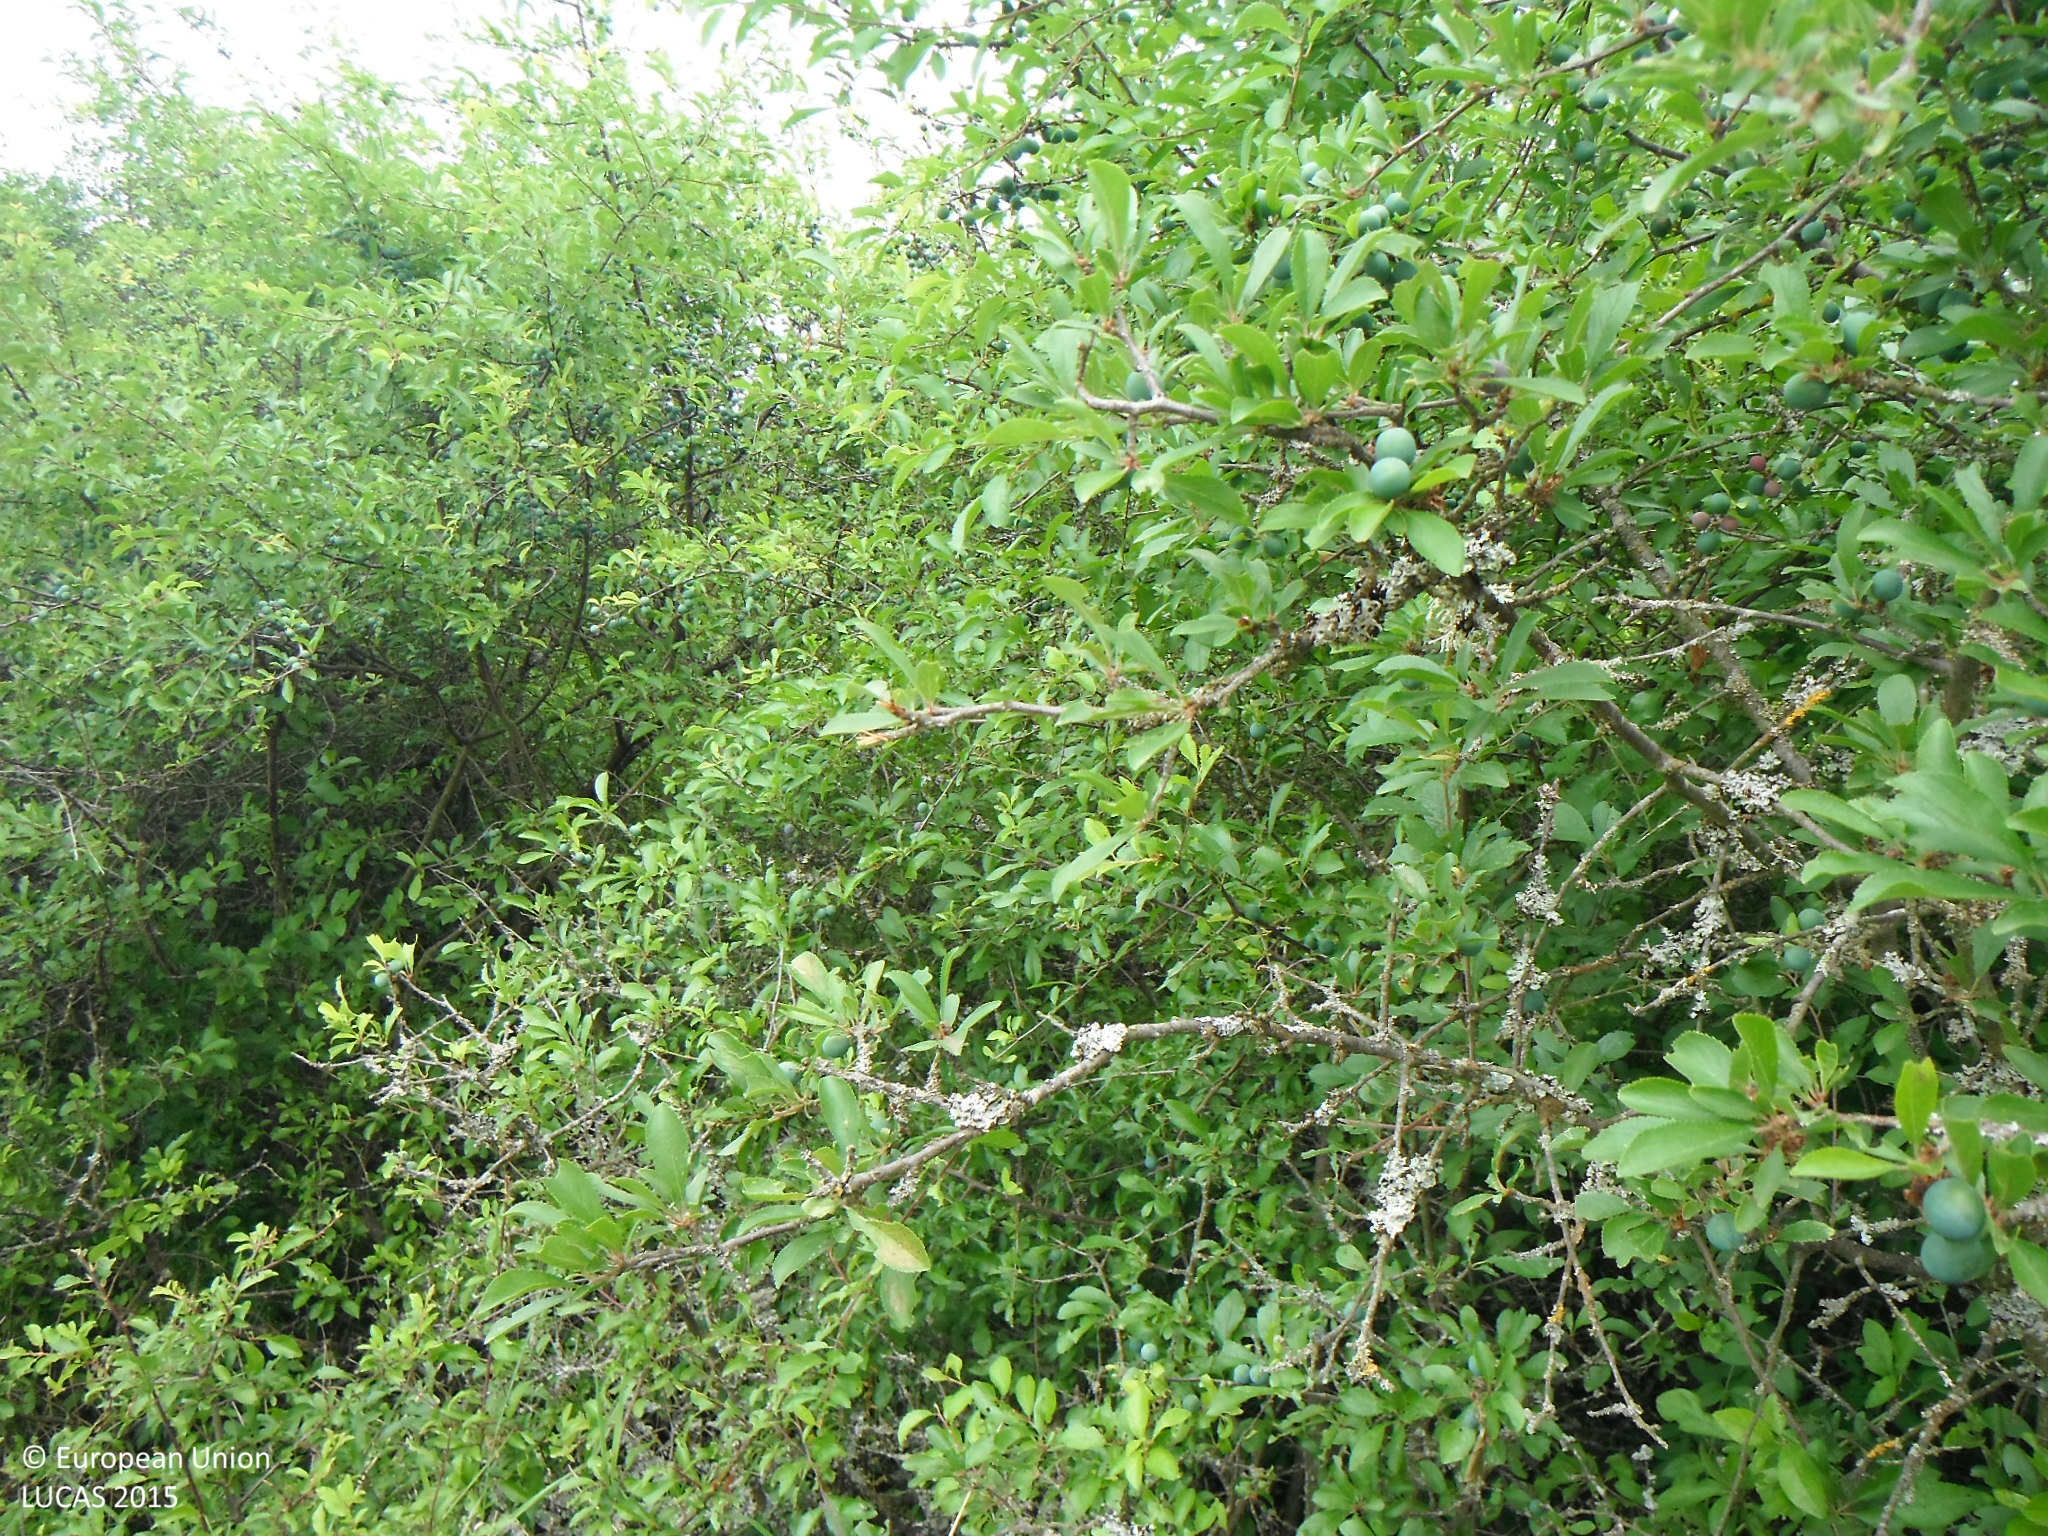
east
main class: Shrubland
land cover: Shrubland with sparse tree cover
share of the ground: > 75 %
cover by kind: shrubs 95 %, broadleaved forest trees 5 %
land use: Semi-natural and natural areas not in use
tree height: > 5 m
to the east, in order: Shrubland with sparse tree cover; Broadleaved woodland; Rivers and streams; Broadleaved woodland; Tracks; Broadleaved woodland
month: June
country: SK
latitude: 48.4441
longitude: 19.9381
